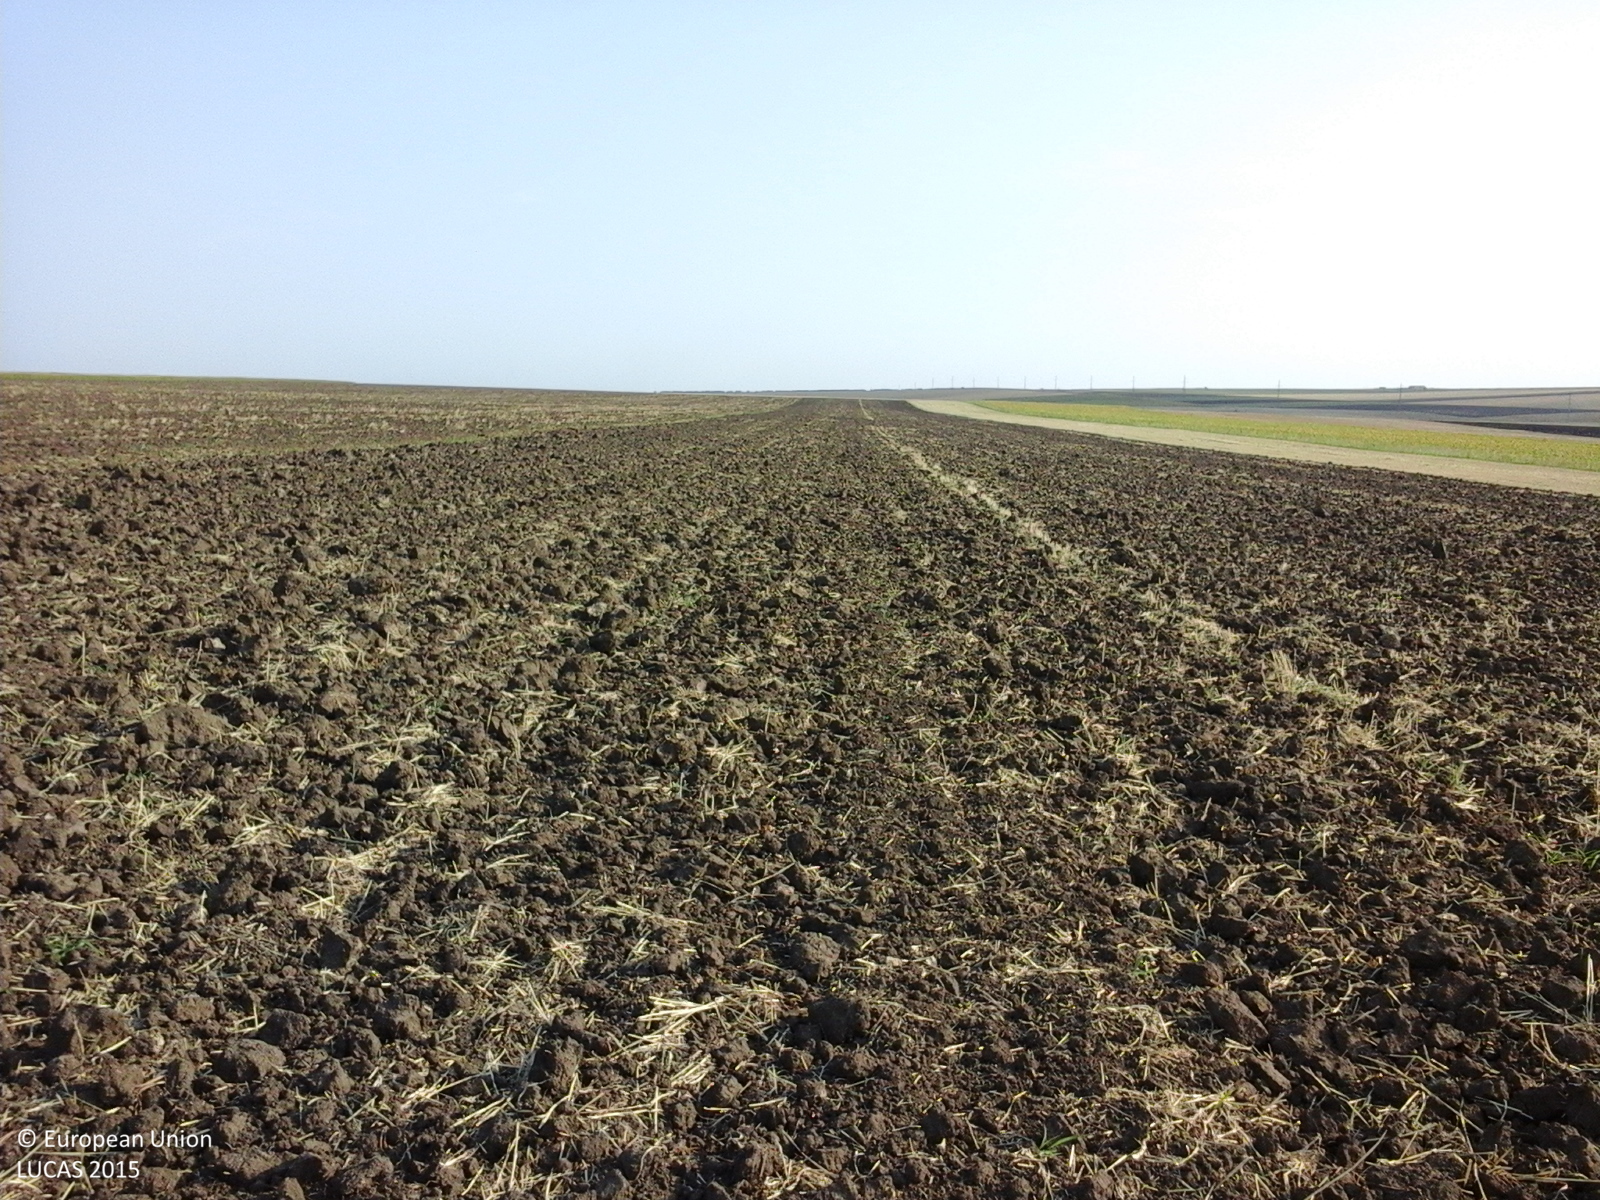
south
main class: Cropland
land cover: Barley
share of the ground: < 10 %
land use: Agriculture (excluding fallow land and kitchen gardens)
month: August
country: RO
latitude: 44.1321
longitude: 28.3758
